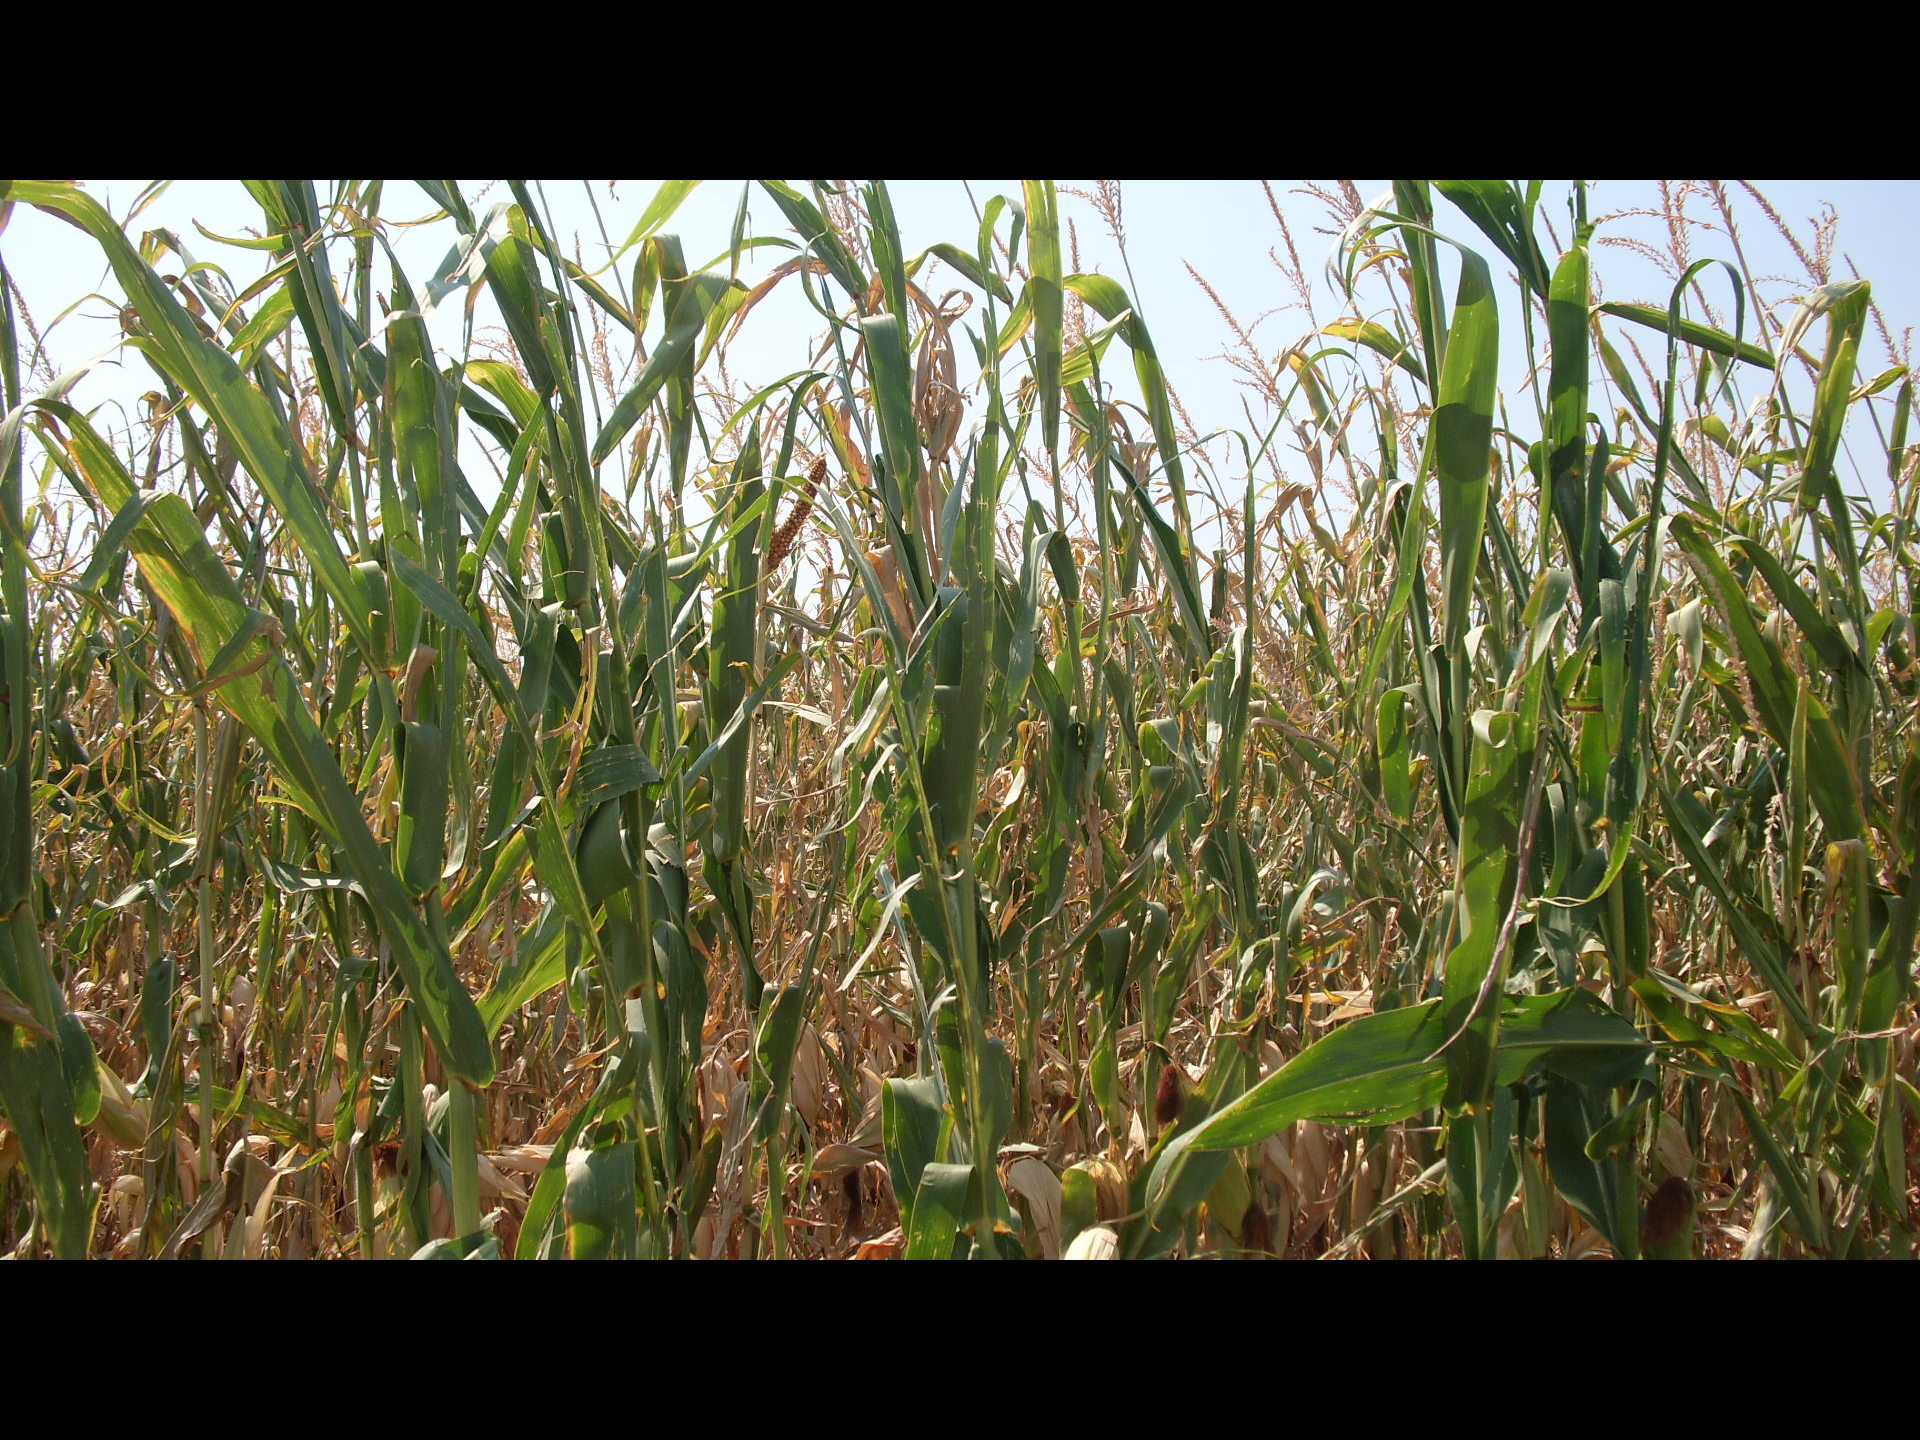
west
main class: Cropland
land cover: Maize
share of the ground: > 75 %
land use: Agriculture (excluding fallow land and kitchen gardens)
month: July
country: BG
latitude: 43.7901
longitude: 23.3797
